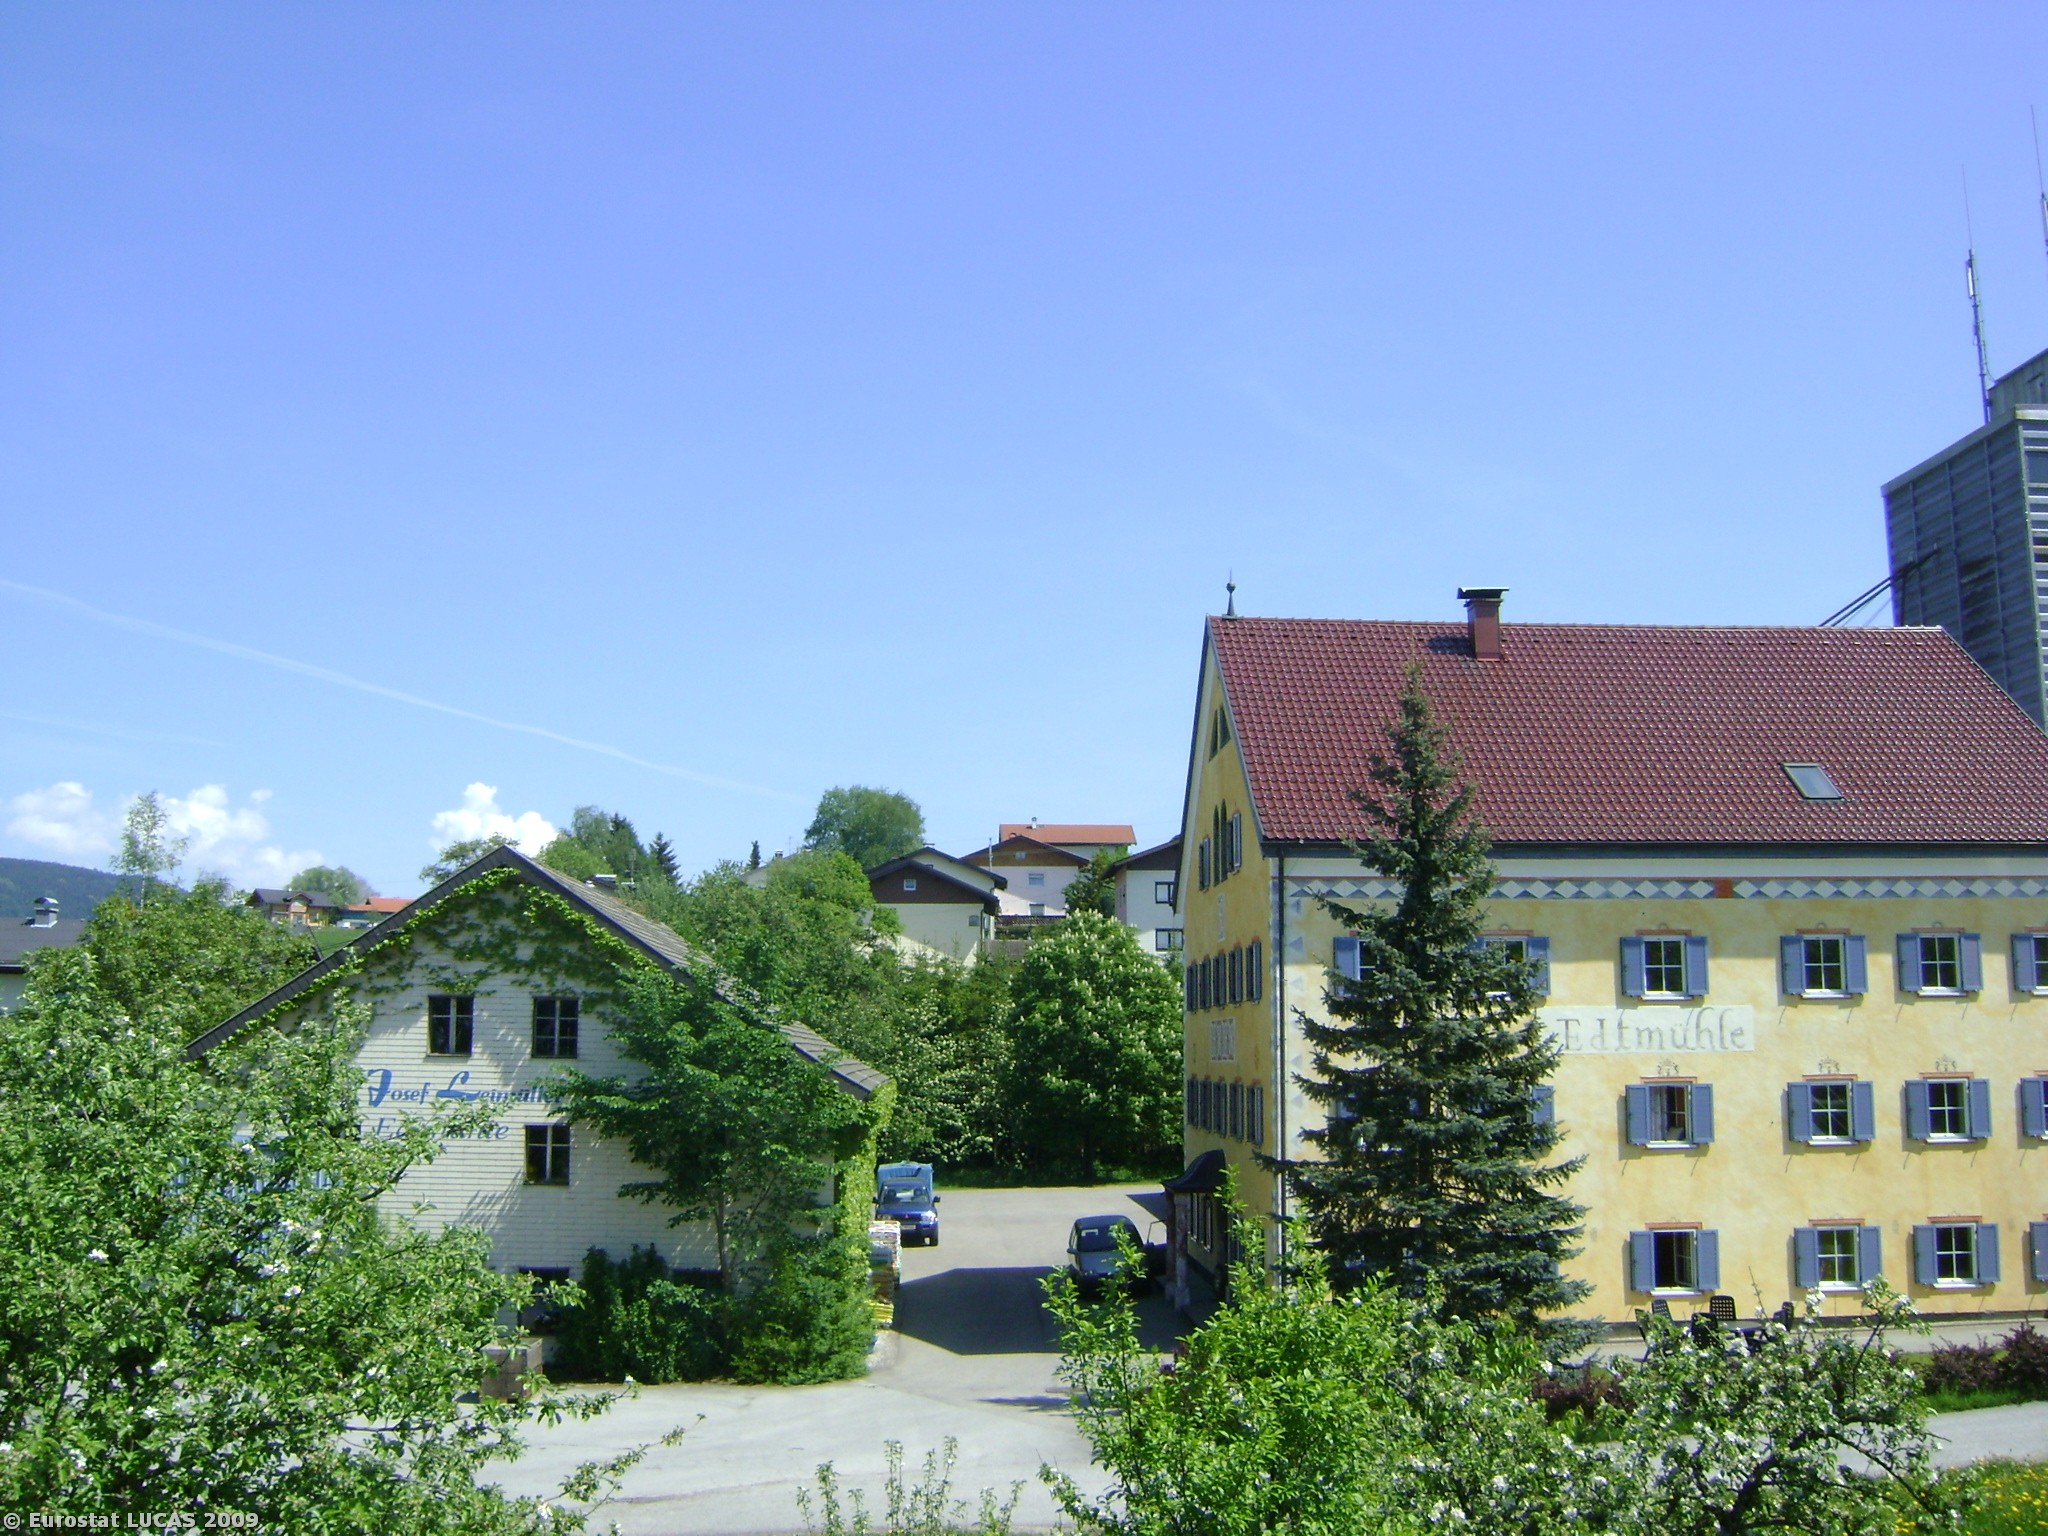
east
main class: Grassland
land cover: Grassland with sparse tree/shrub cover
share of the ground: > 75 %
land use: Agriculture (excluding fallow land and kitchen gardens)
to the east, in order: Grassland with sparse tree/shrub cover; Paved roads, cycling and walking lanes; Artificial constructions in urban areas
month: May
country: AT
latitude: 47.9423
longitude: 13.2253
